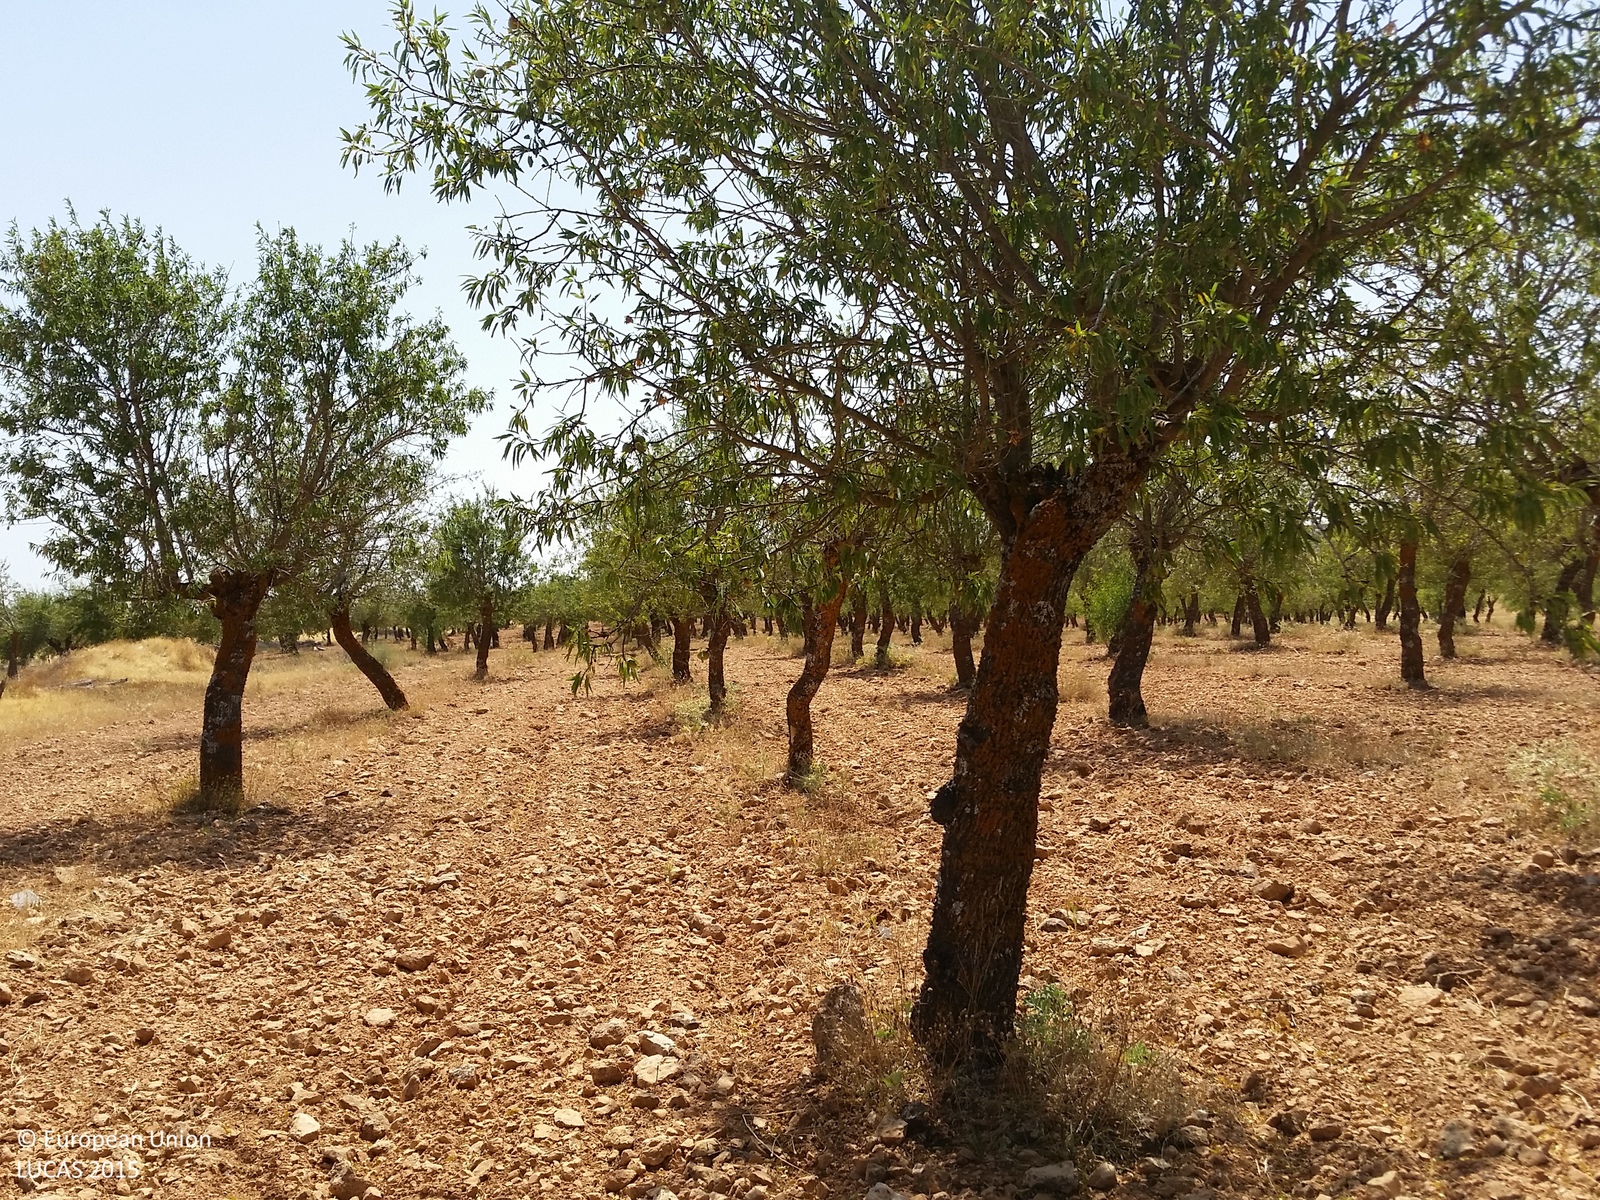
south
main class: Cropland
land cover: Nuts trees
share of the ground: 50 - 75 %
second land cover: Spontaneously vegetated surfaces
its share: 25 - 50 %
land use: Agriculture (excluding fallow land and kitchen gardens)
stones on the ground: 10 - 25 %
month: July
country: ES
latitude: 38.8955
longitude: -2.5142
